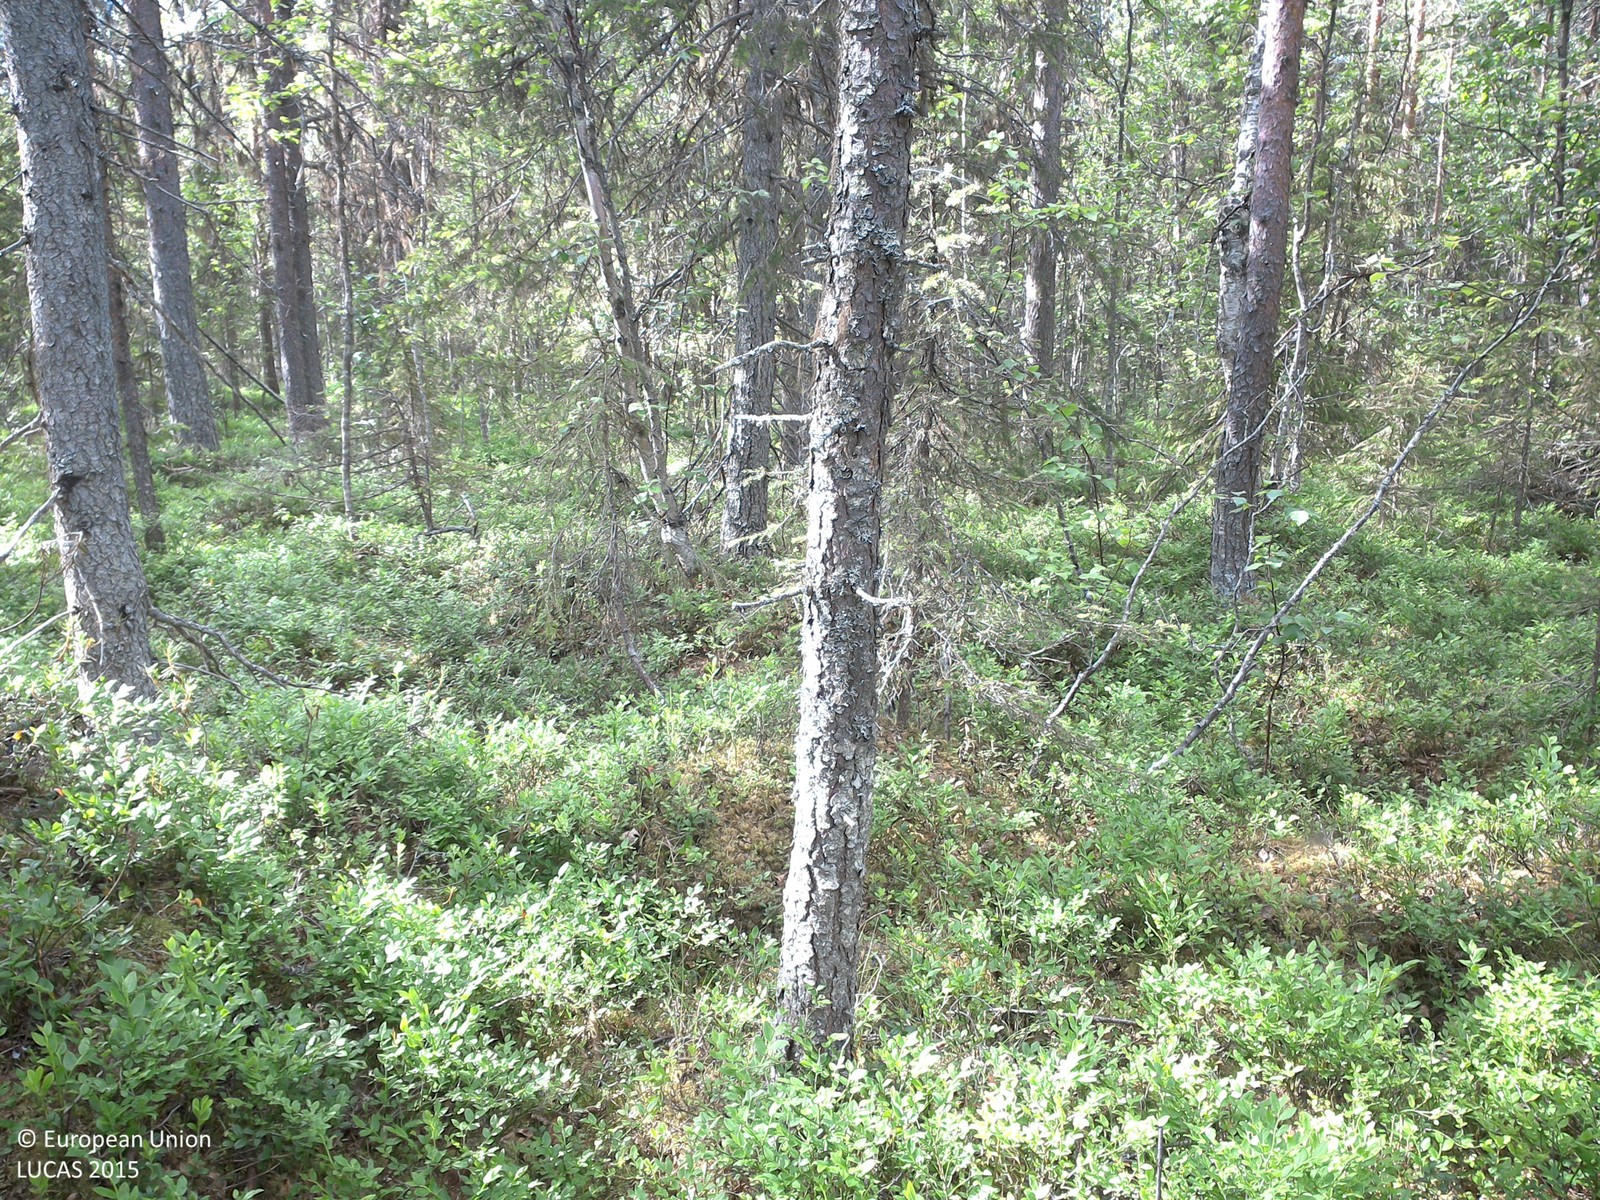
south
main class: Woodland
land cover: Spruce dominated mixed woodland
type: boreal forest
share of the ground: 25 - 50 %
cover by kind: shrubs 55 %, coniferous forest trees 30 %, broadleaved forest trees 10 %, lichens and mosses 5 %
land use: Forestry
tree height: > 5 m
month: July
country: SE
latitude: 67.1392
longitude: 22.6744
